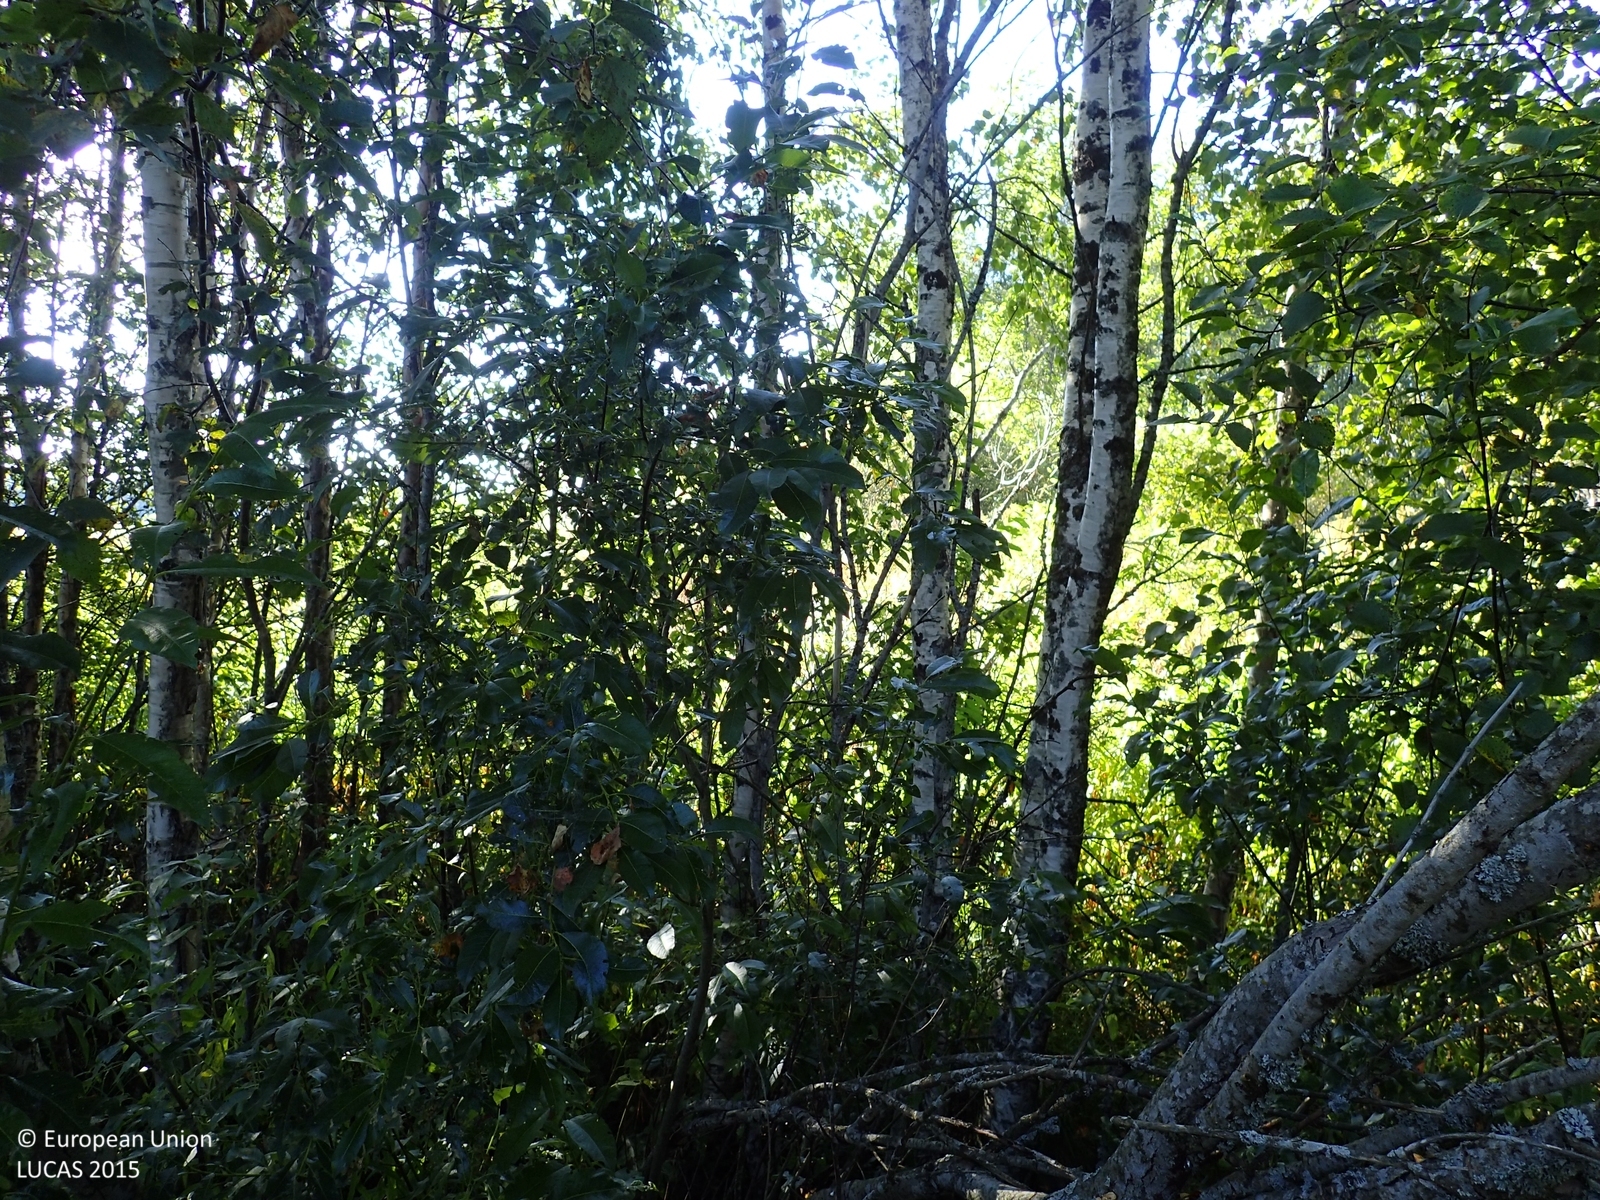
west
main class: Woodland
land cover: Broadleaved woodland
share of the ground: > 75 %
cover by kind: broadleaved forest trees 90 %, herbaceous plants 10 %
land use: Abandoned areas
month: August
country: FI
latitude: 62.5503
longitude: 22.0077
